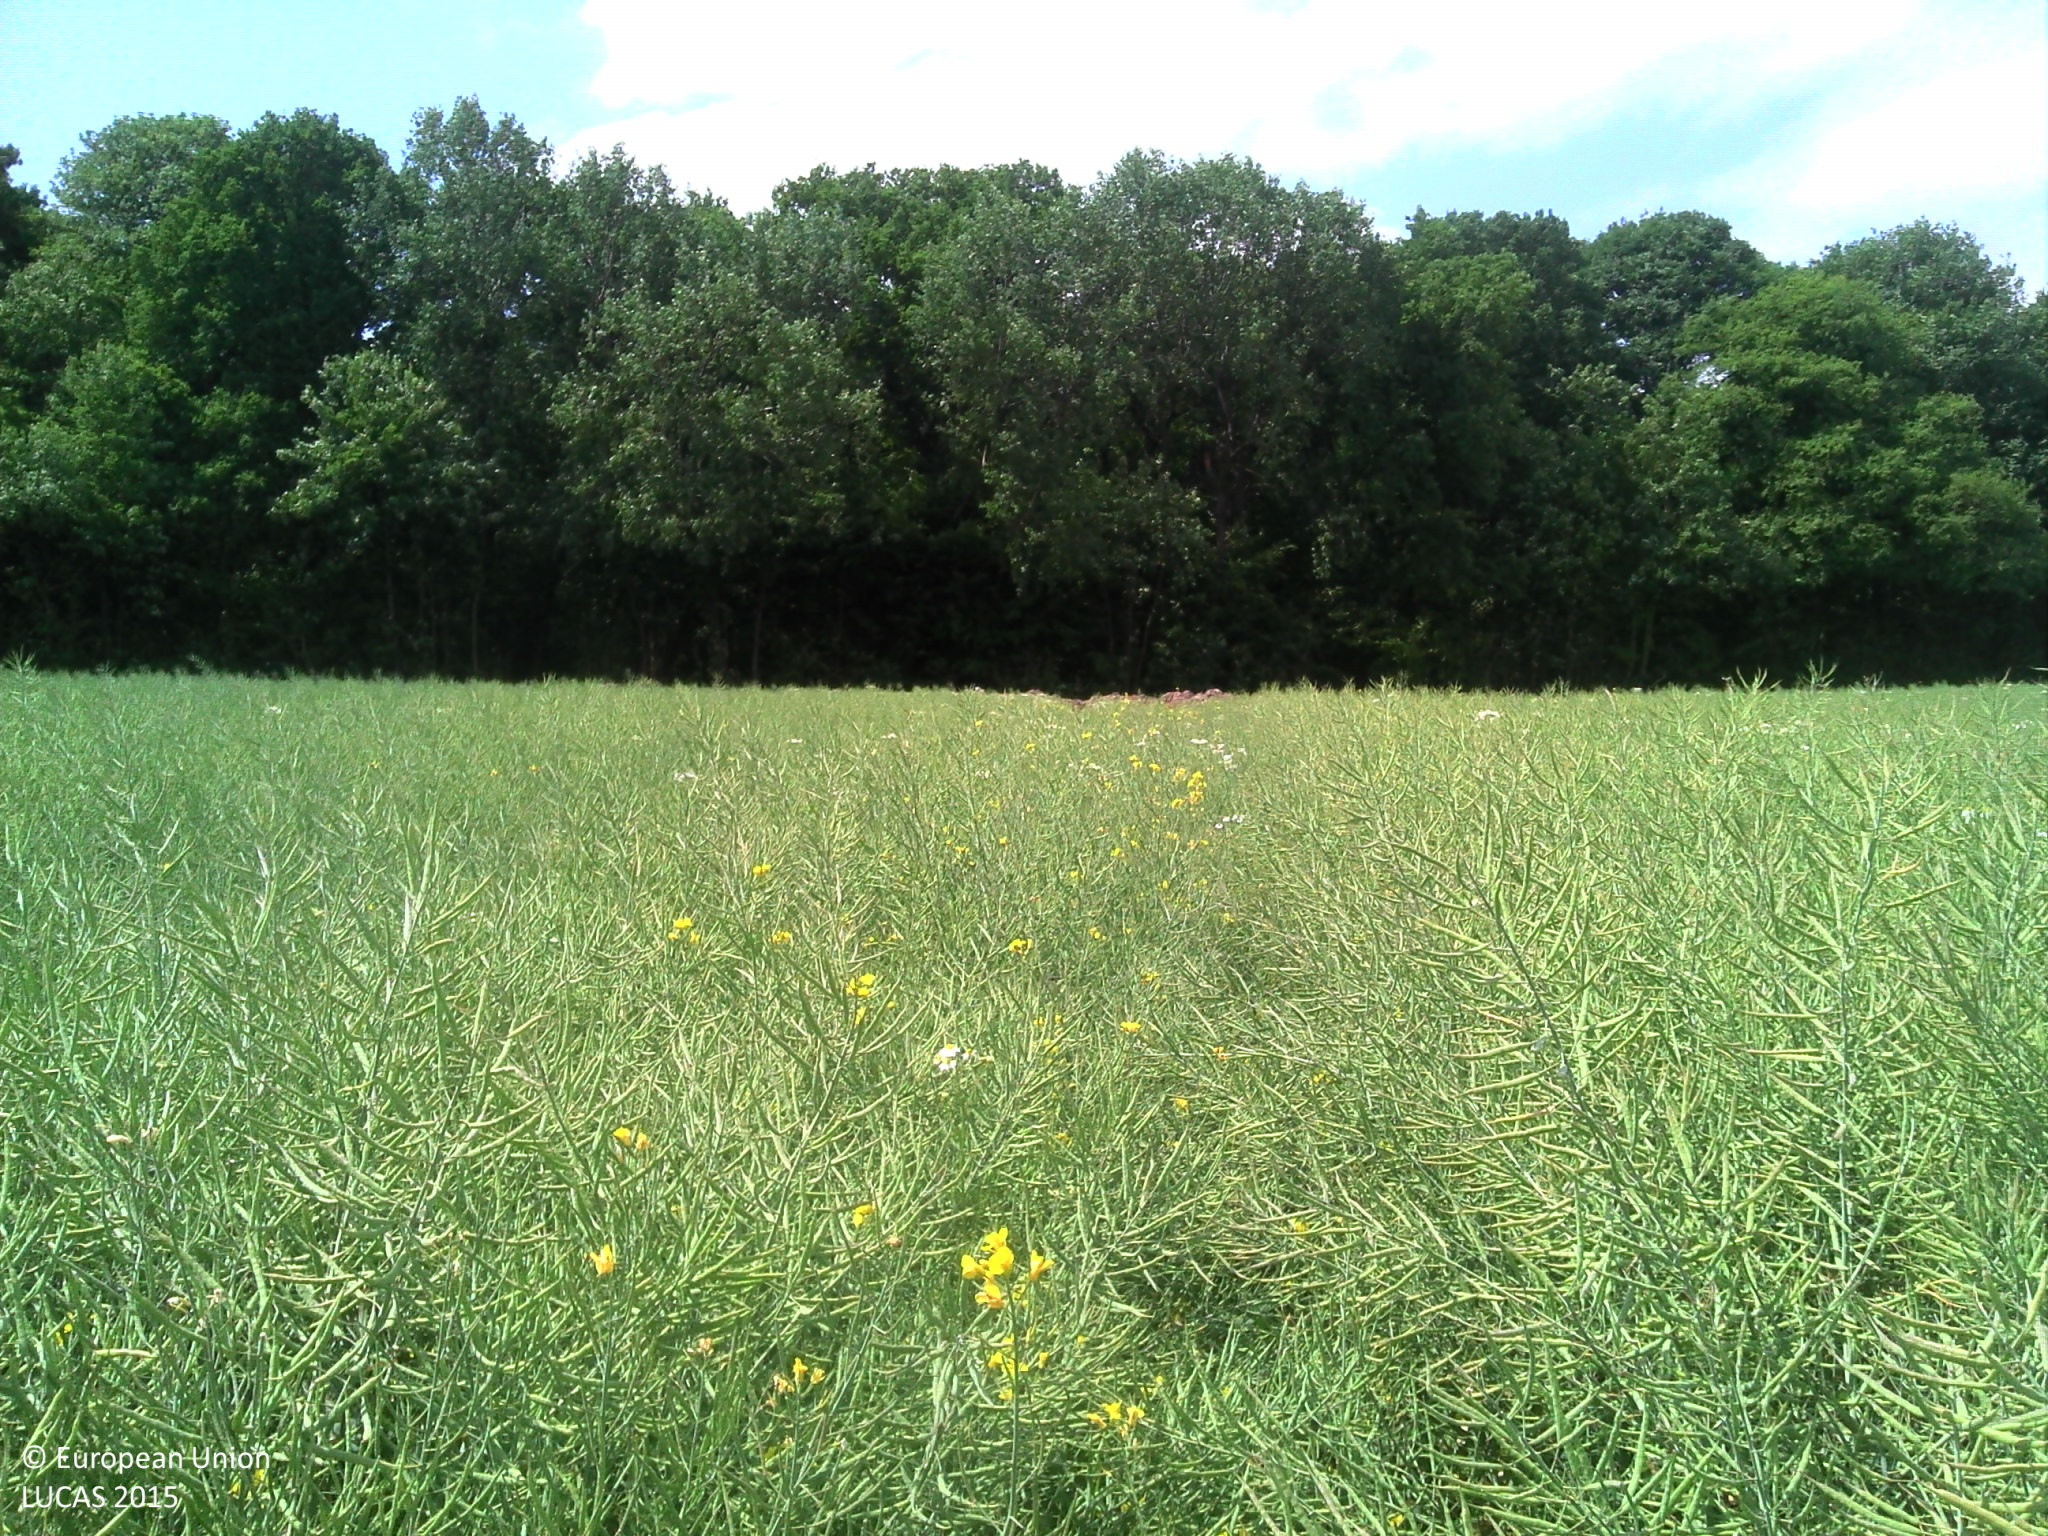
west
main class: Cropland
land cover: Rape and turnip rape
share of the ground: > 75 %
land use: Agriculture (excluding fallow land and kitchen gardens)
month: June
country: BE
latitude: 50.3646
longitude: 4.6402
